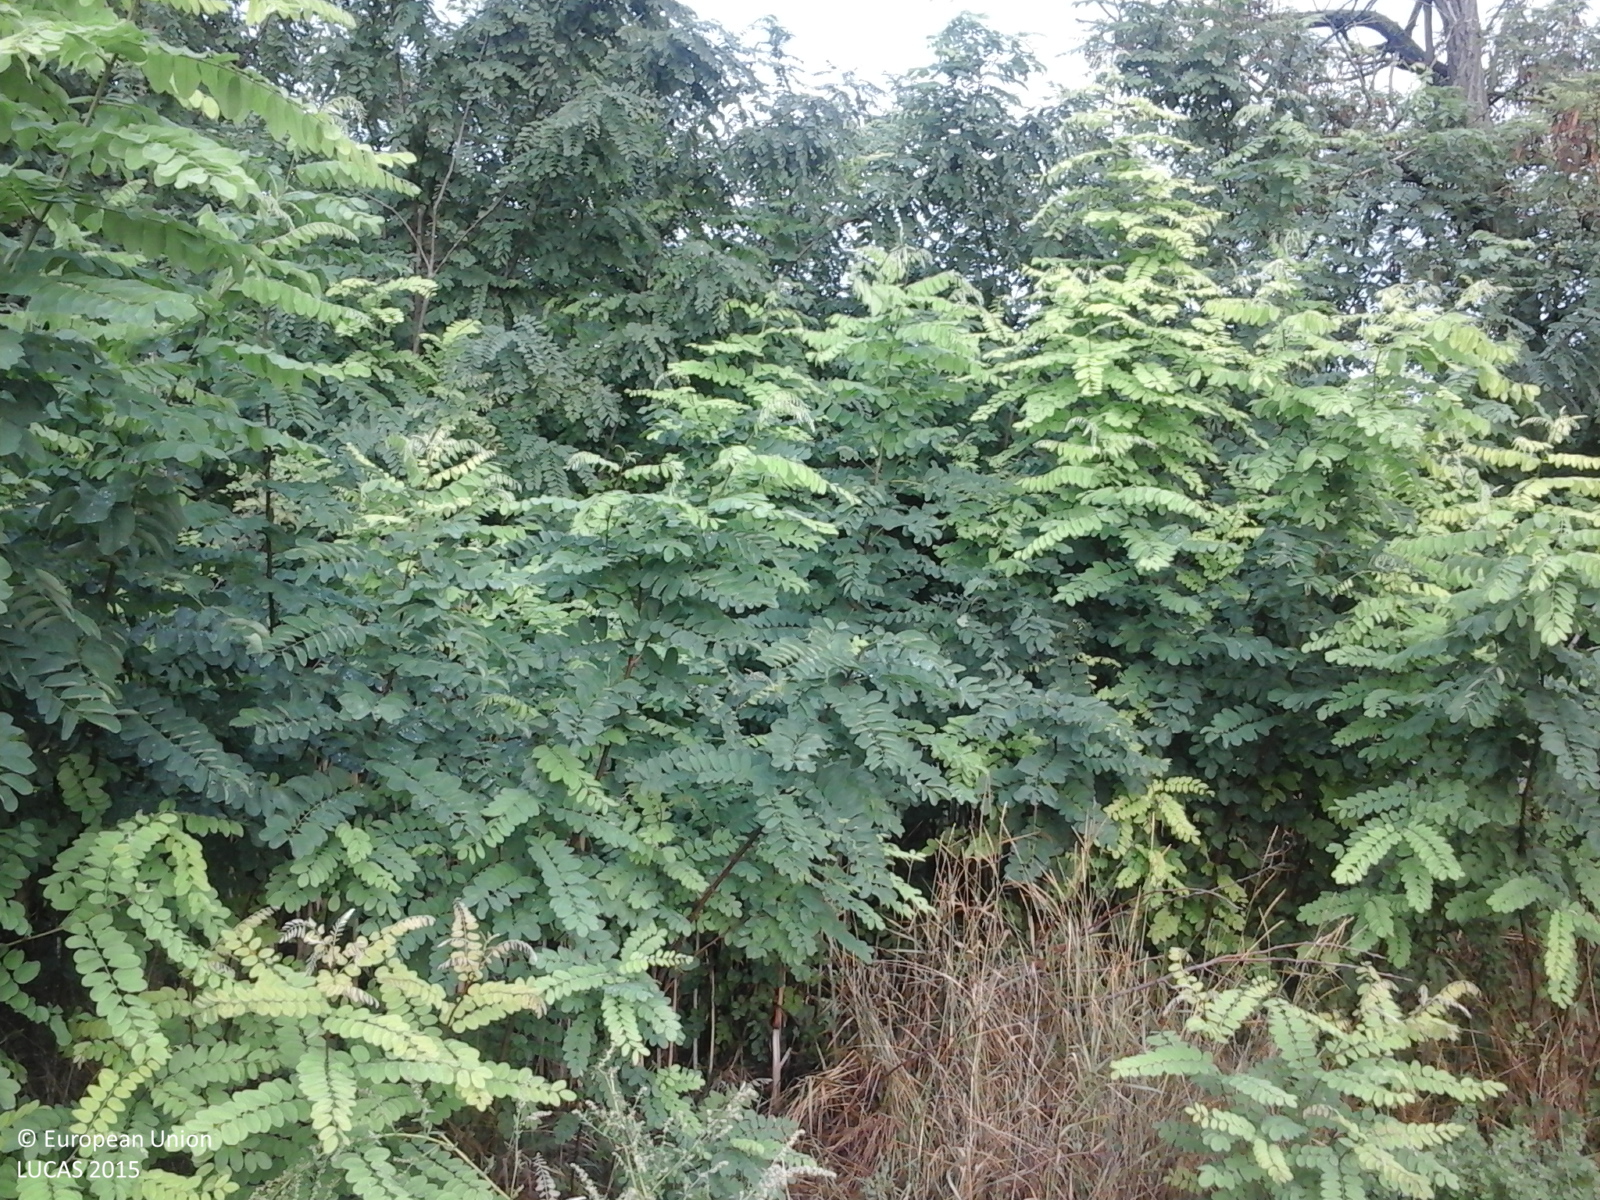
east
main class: Grassland
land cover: Grassland with sparse tree/shrub cover
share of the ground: > 75 %
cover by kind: herbaceous plants 90 %, broadleaved forest trees 5 %, shrubs 5 %
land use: Agriculture (excluding fallow land and kitchen gardens)
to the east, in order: Grassland with sparse tree/shrub cover; Grass margins; Ditches and canals; Paved roads, cycling and walking lanes; Grass margins; Grassland with sparse tree/shrub cover; Fences; Common wheat; Lines of trees; Grassland without tree/shrub cover
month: August
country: RO
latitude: 45.9100
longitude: 20.8171
